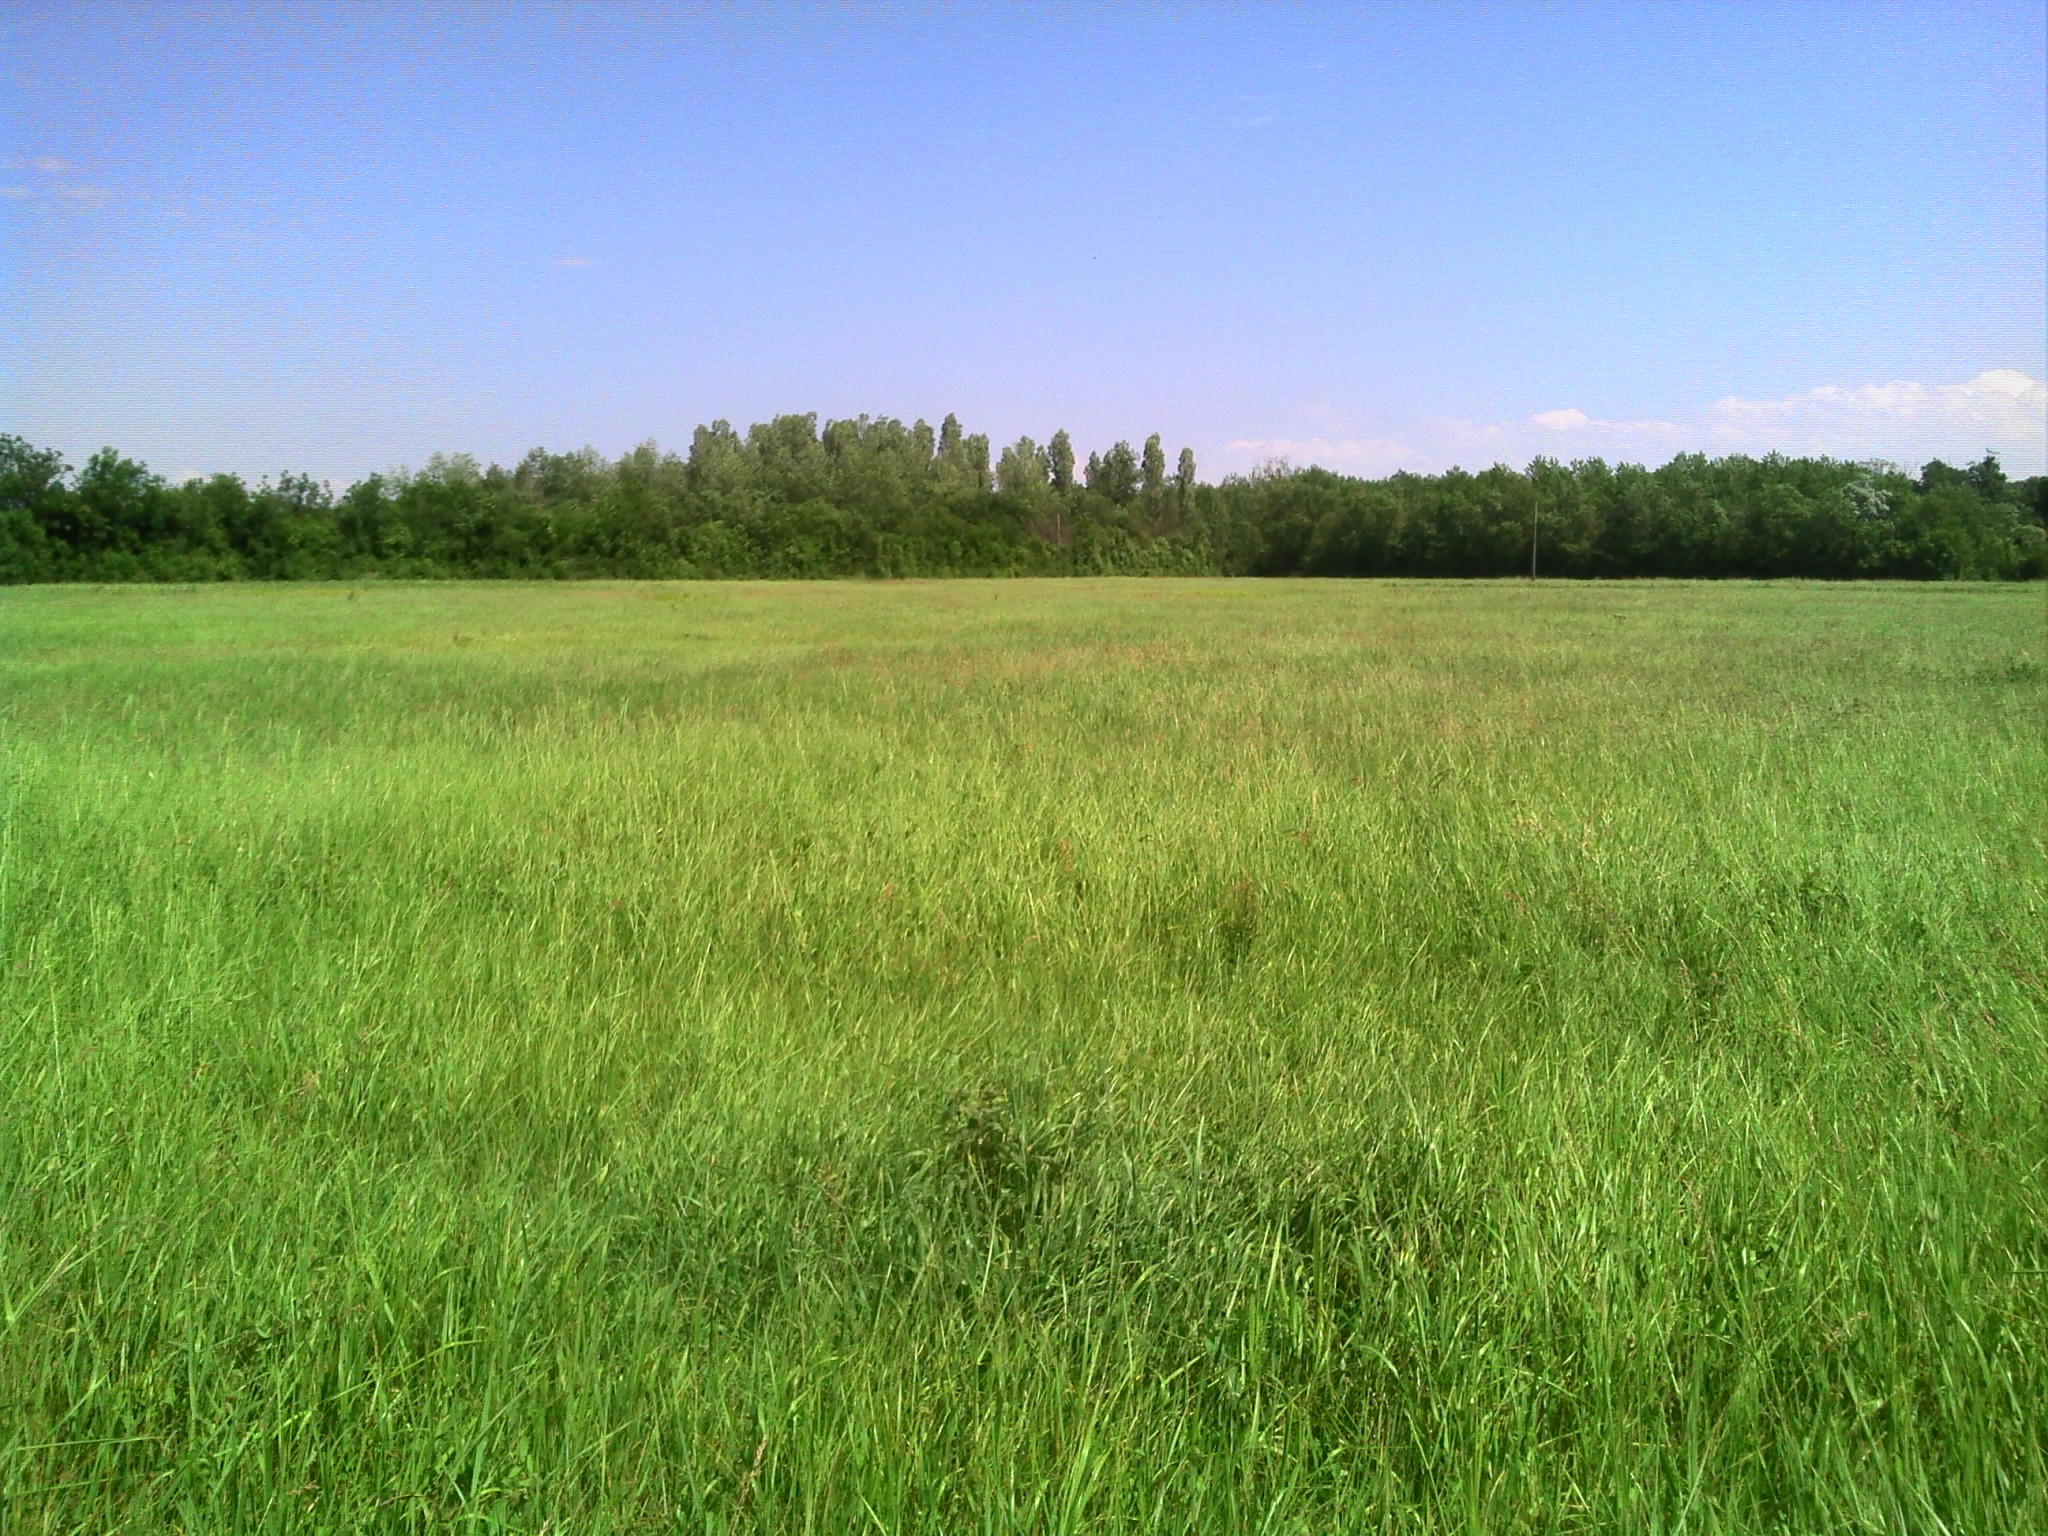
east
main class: Grassland
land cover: Grassland without tree/shrub cover
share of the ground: > 75 %
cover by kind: herbaceous plants 100 %
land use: Agriculture (excluding fallow land and kitchen gardens)
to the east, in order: Grassland without tree/shrub cover; Electric lines; Grassland without tree/shrub cover; Broadleaved woodland; Grassland without tree/shrub cover
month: May
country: FR
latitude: 46.5737
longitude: 4.9262
